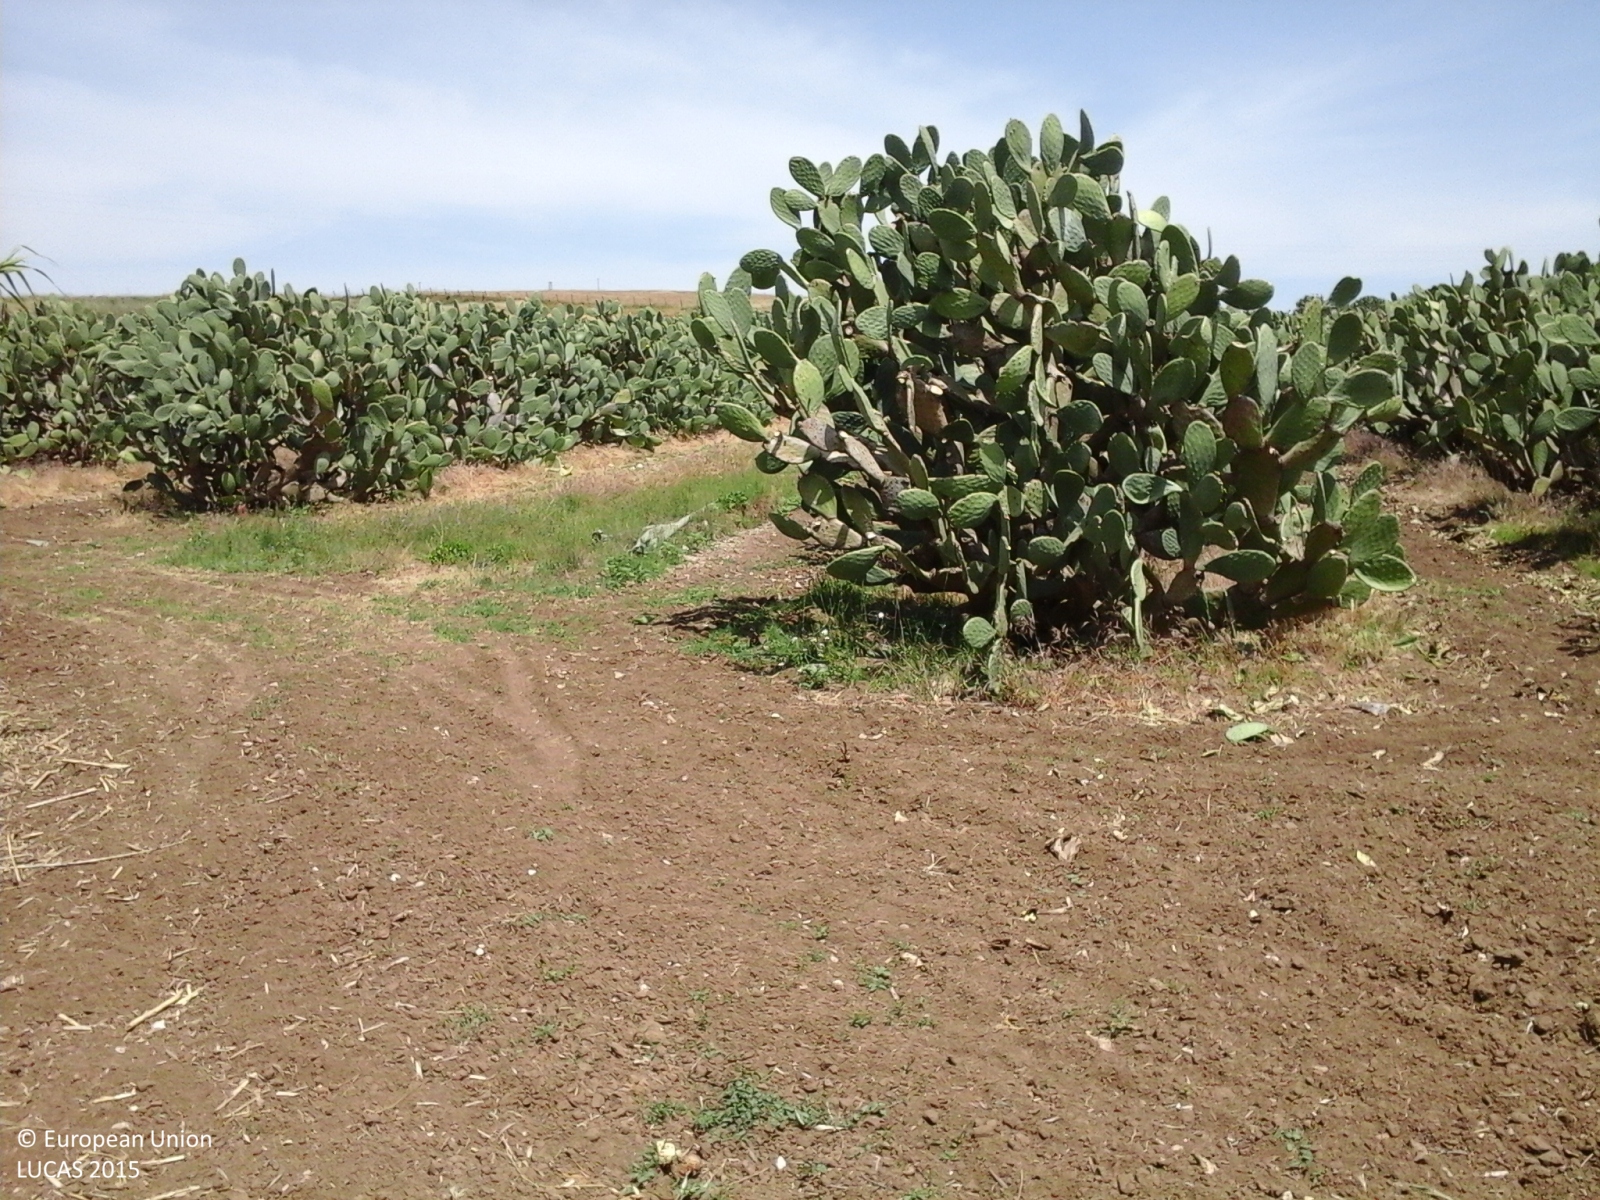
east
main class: Grassland
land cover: Spontaneously vegetated surfaces
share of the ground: 25 - 50 %
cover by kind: herbaceous plants 100 %
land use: Fallow land
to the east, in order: Spontaneously vegetated surfaces; Abandoned hedges; Ditches and canals; Abandoned hedges; Other fruit trees and berries; Electric lines; Other fruit trees and berries; Grass margins; Fences; Grass margins; Paved roads, cycling and walking lanes; Grass margins; Oats
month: May
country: IT
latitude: 37.3205
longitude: 14.3566
